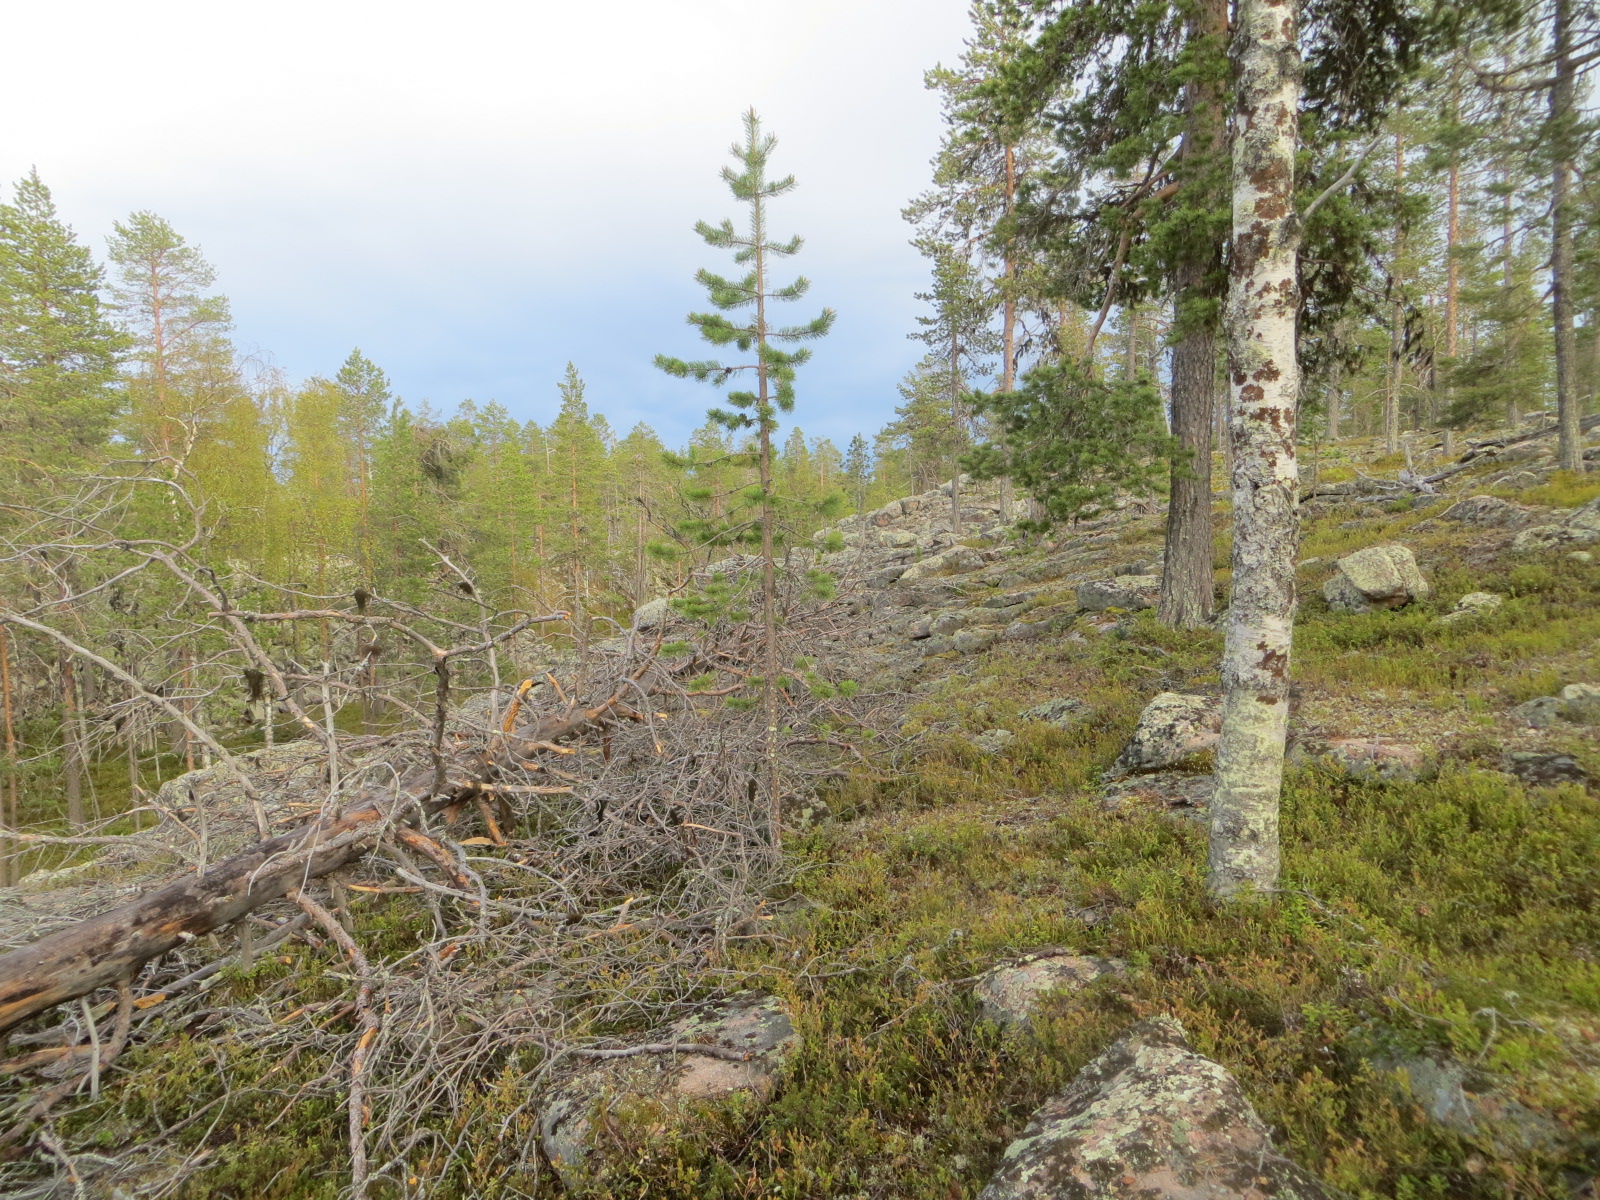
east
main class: Woodland
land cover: Pine dominated coniferous woodland
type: boreal forest
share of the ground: 50 - 75 %
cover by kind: coniferous forest trees 50 %, shrubs 25 %, consolidated bare surface 25 %
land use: Forestry
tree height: > 5 m
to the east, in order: Pine dominated coniferous woodland; Rocks and stones; Pine dominated mixed woodland; Rocks and stones; Pine dominated coniferous woodland
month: June
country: FI
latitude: 67.4126
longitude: 25.6620
